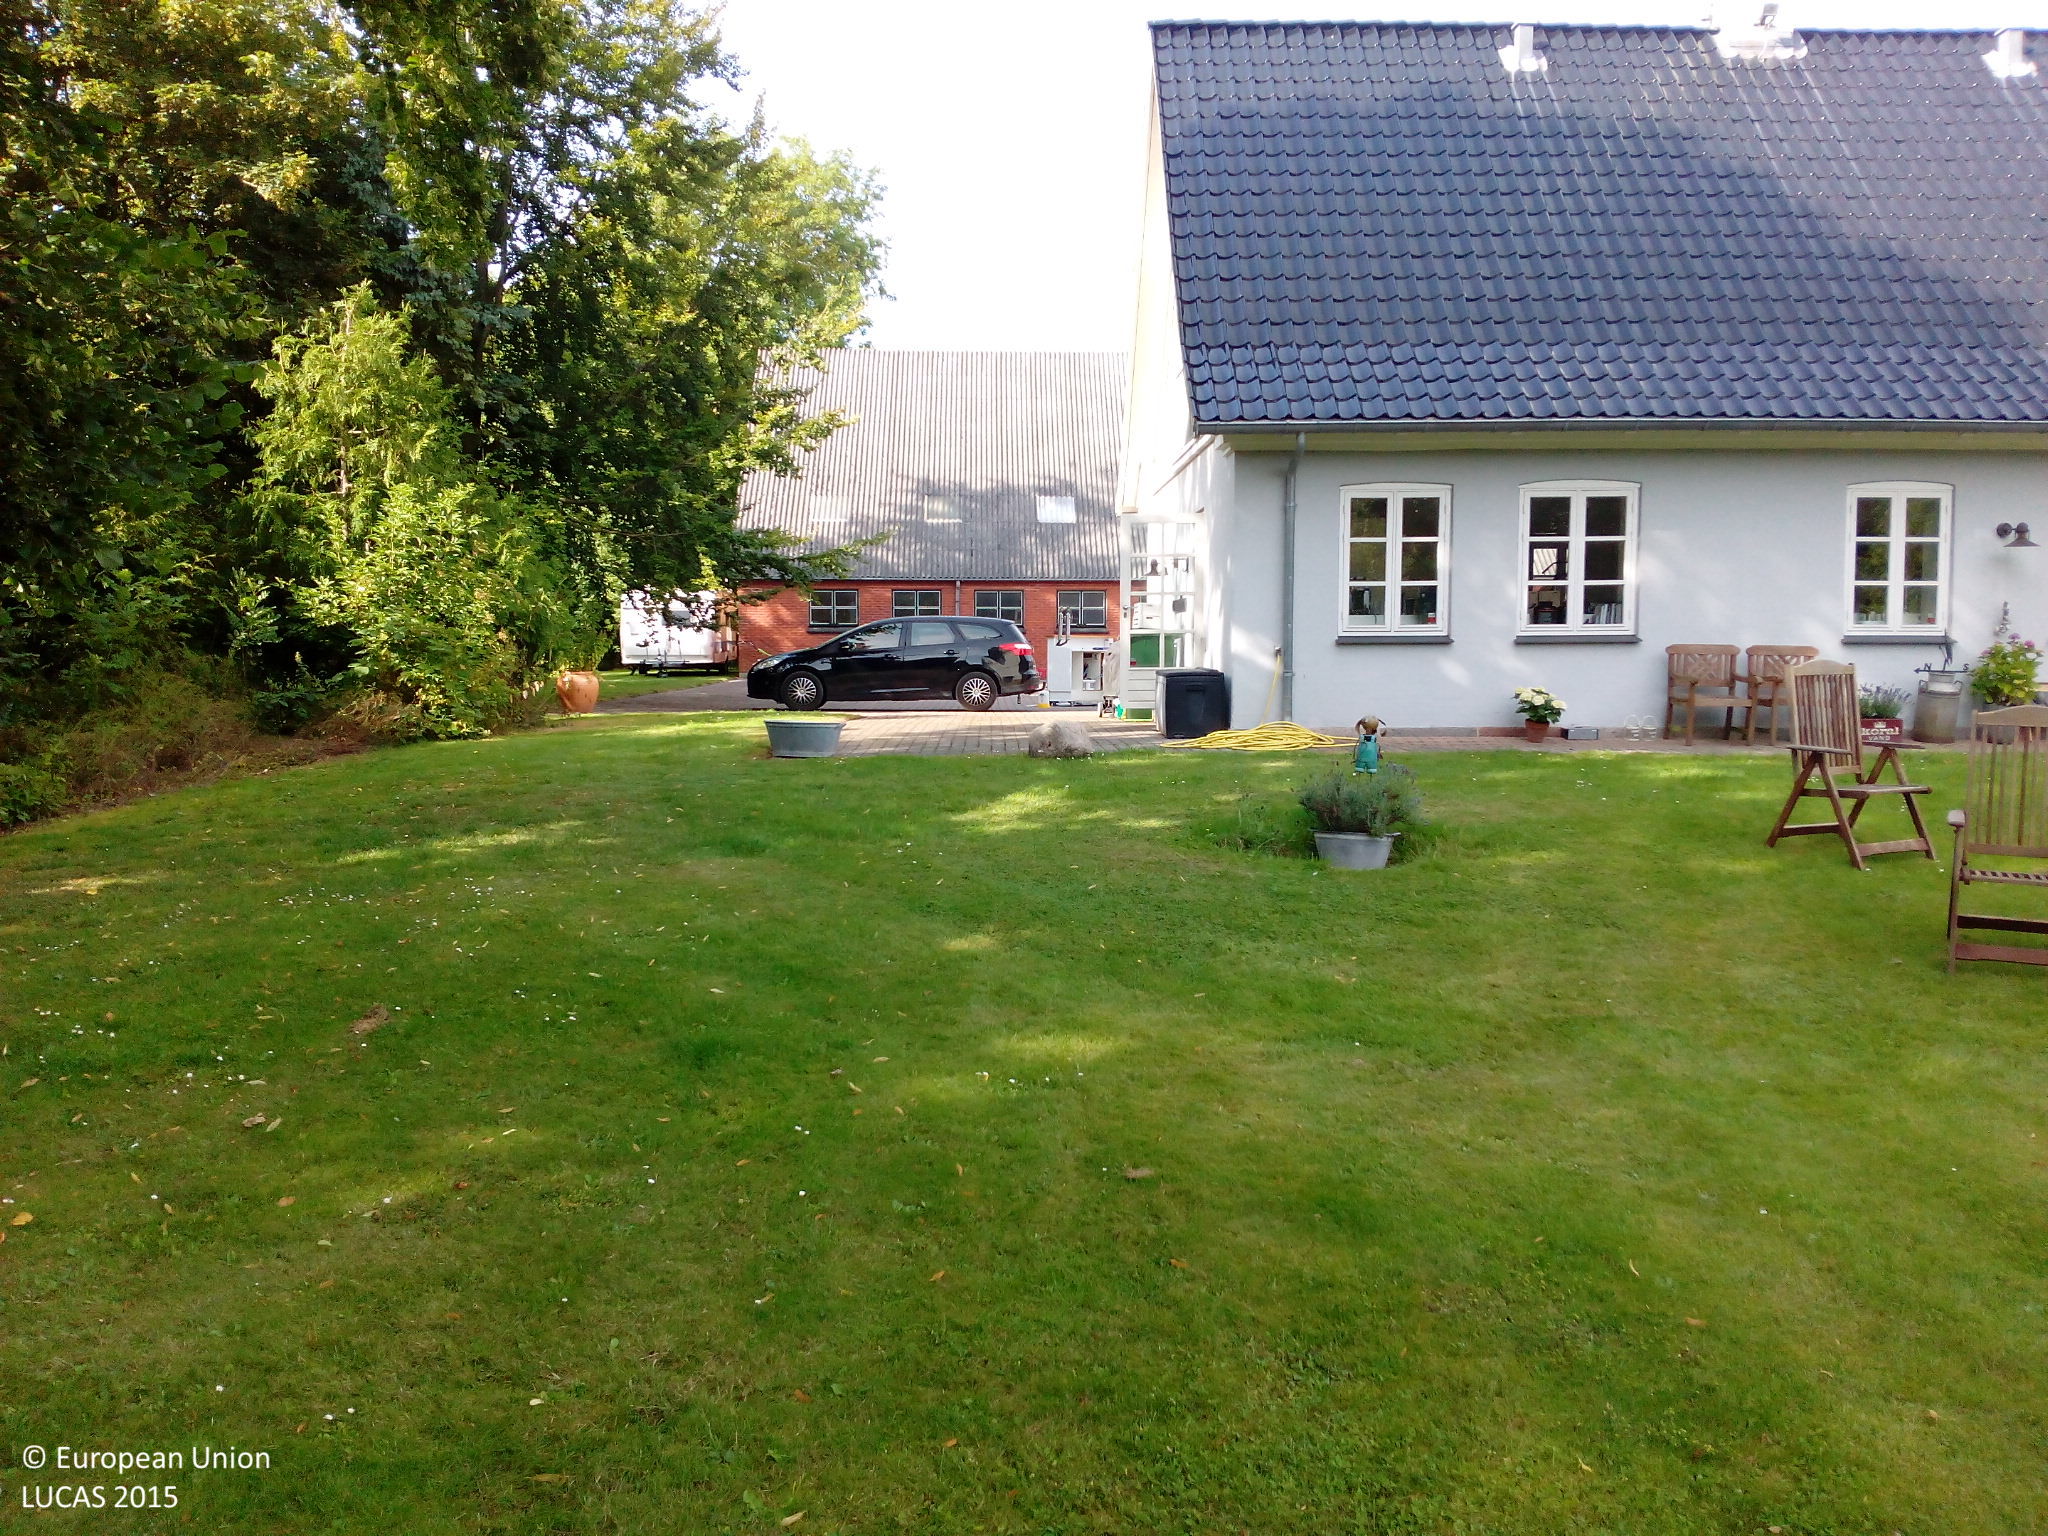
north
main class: Grassland
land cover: Grassland without tree/shrub cover
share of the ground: > 75 %
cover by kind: herbaceous plants 100 %
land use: Residential
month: August
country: DK
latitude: 55.6125
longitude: 12.1415
